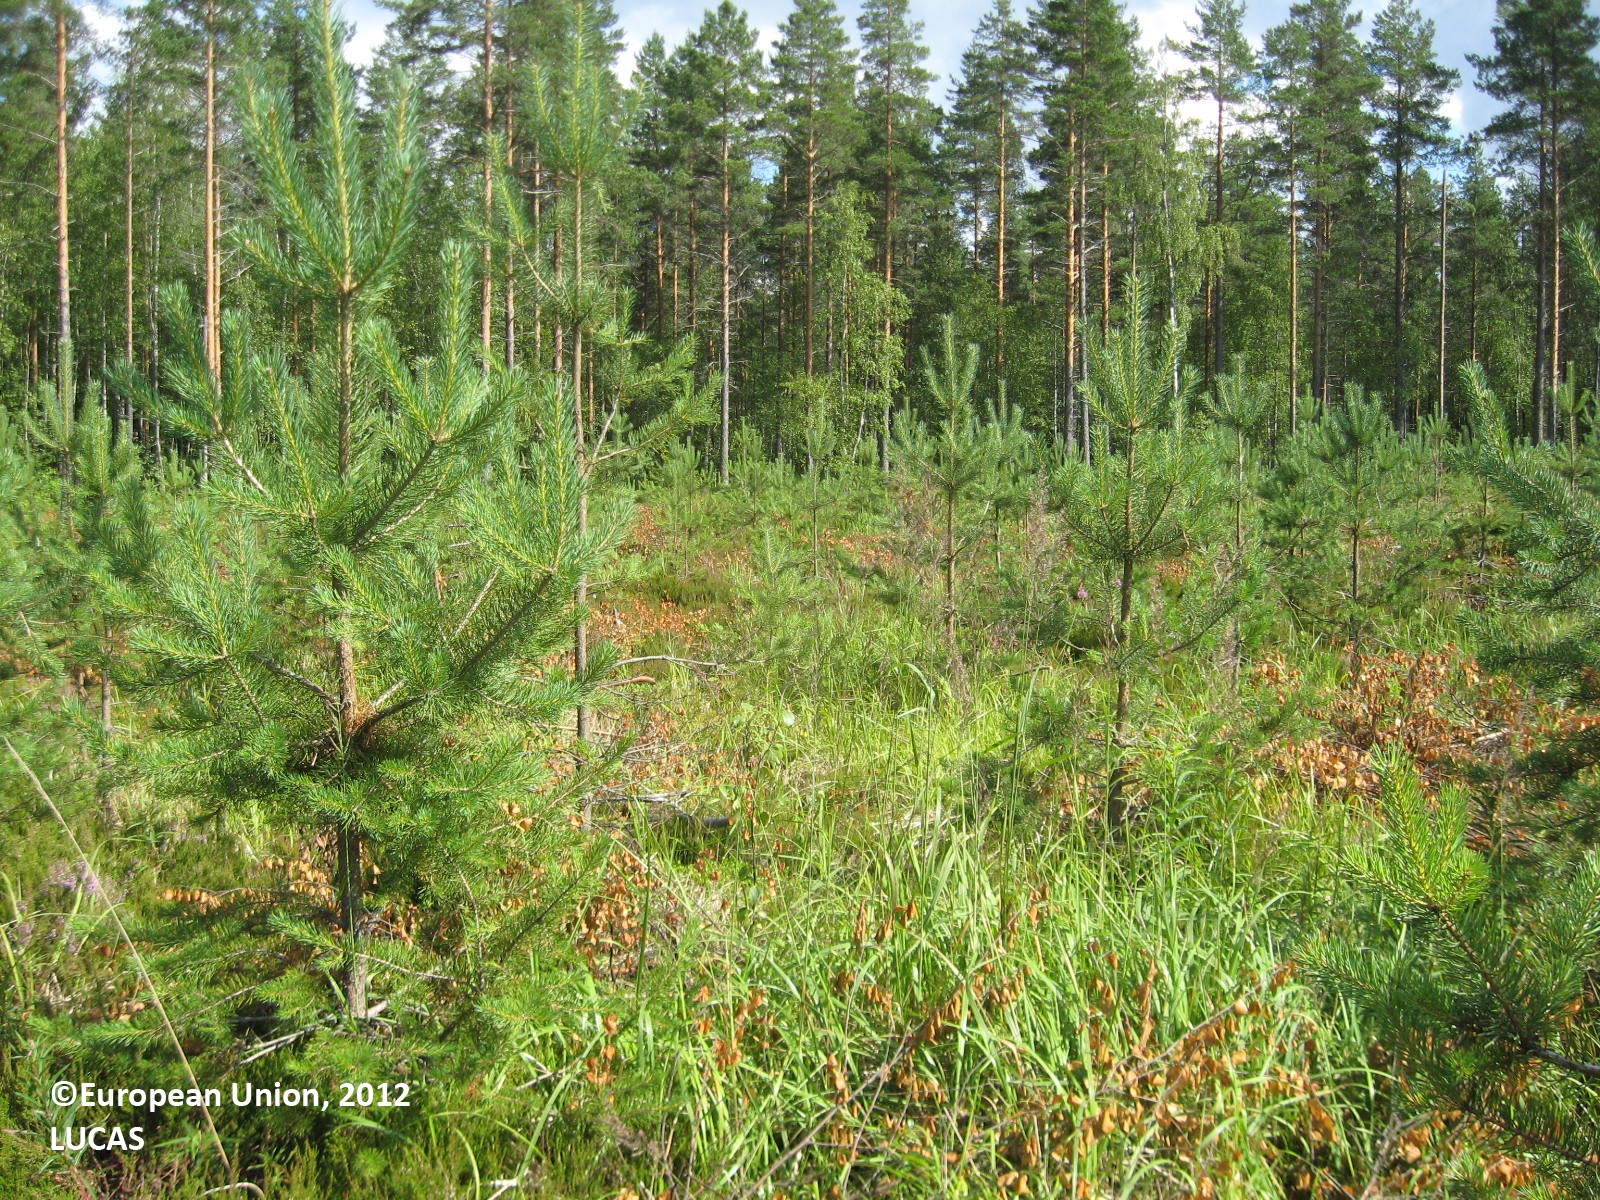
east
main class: Woodland
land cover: Pine dominated coniferous woodland
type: boreal forest
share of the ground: 25 - 50 %
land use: Forestry
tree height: < 5 m
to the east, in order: Pine dominated coniferous woodland; Ditches and canals; Pine dominated mixed woodland; Ditches and canals; Other mixed woodland; Ditches and canals; Pine dominated mixed woodland
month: July
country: FI
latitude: 62.0002
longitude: 22.6834
